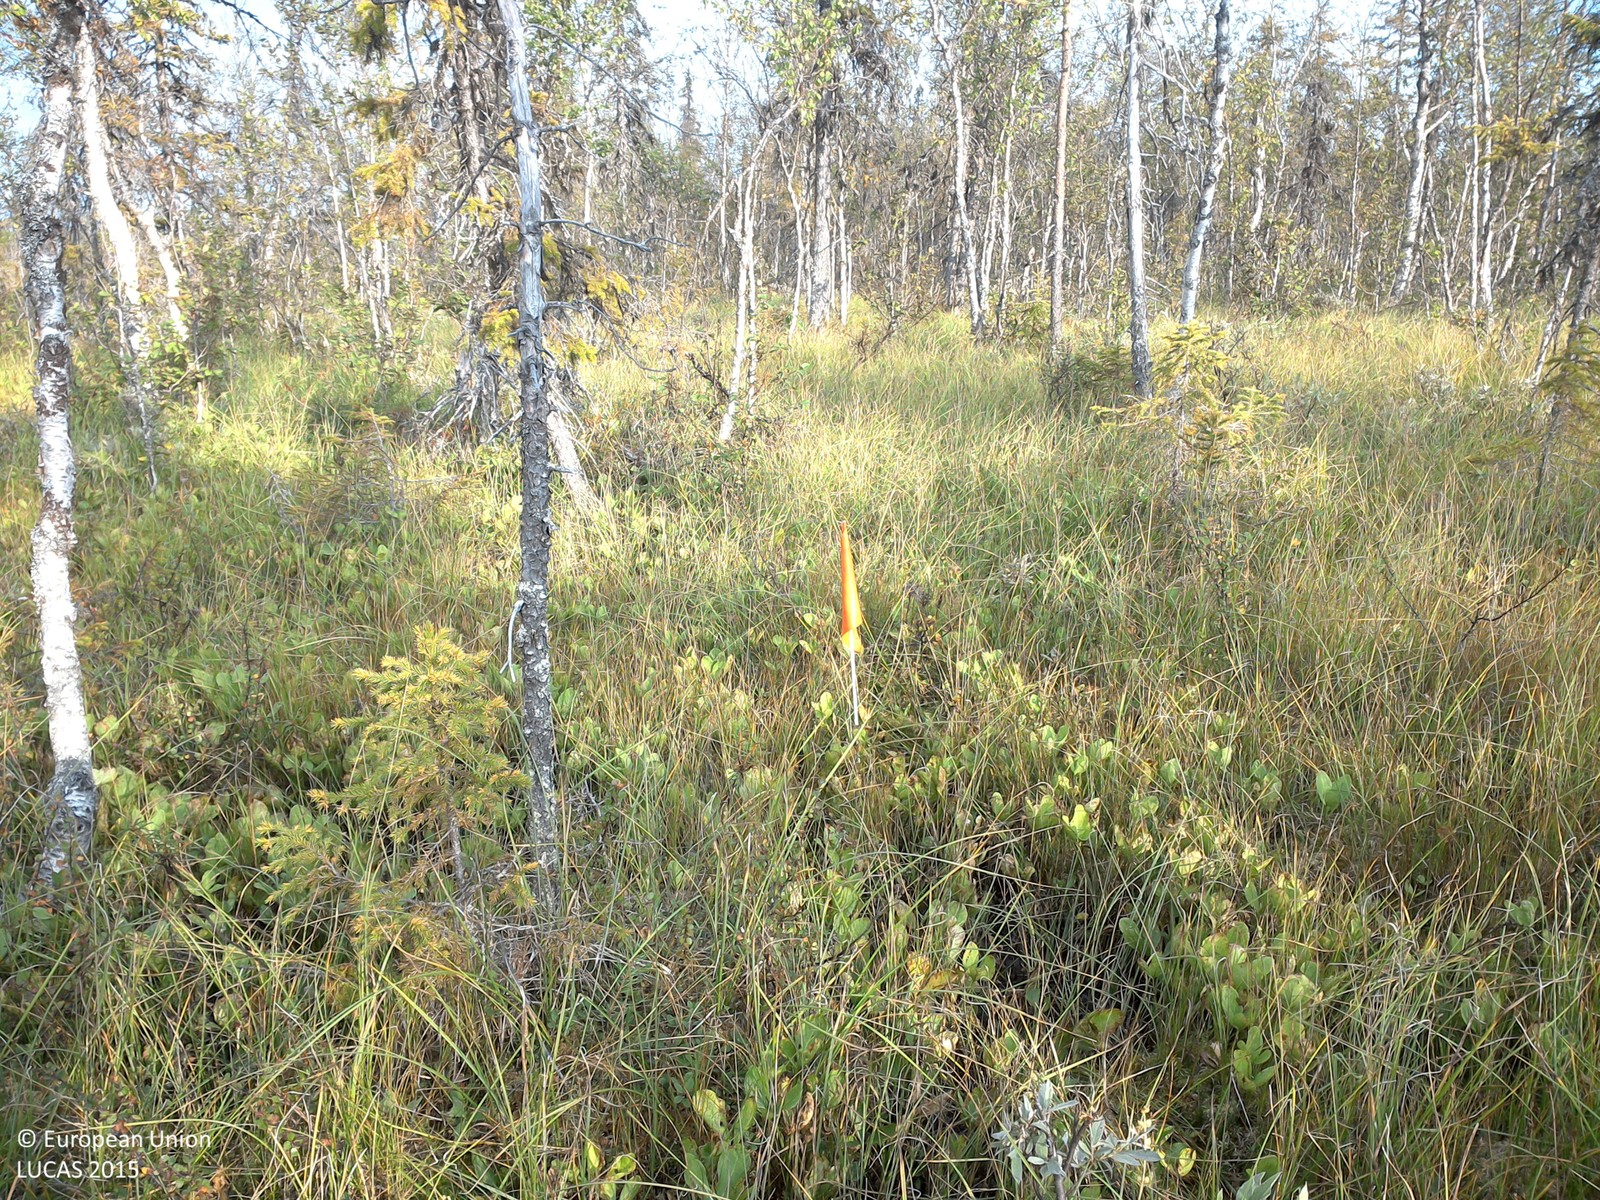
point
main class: Woodland
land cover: Other mixed woodland
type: mire and swamp forests
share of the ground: 10 - 25 %
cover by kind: herbaceous plants 55 %, lichens and mosses 20 %, coniferous forest trees 10 %, shrubs 10 %, broadleaved forest trees 5 %
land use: Semi-natural and natural areas not in use
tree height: > 5 m
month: August
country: SE
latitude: 67.2615
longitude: 21.9890
